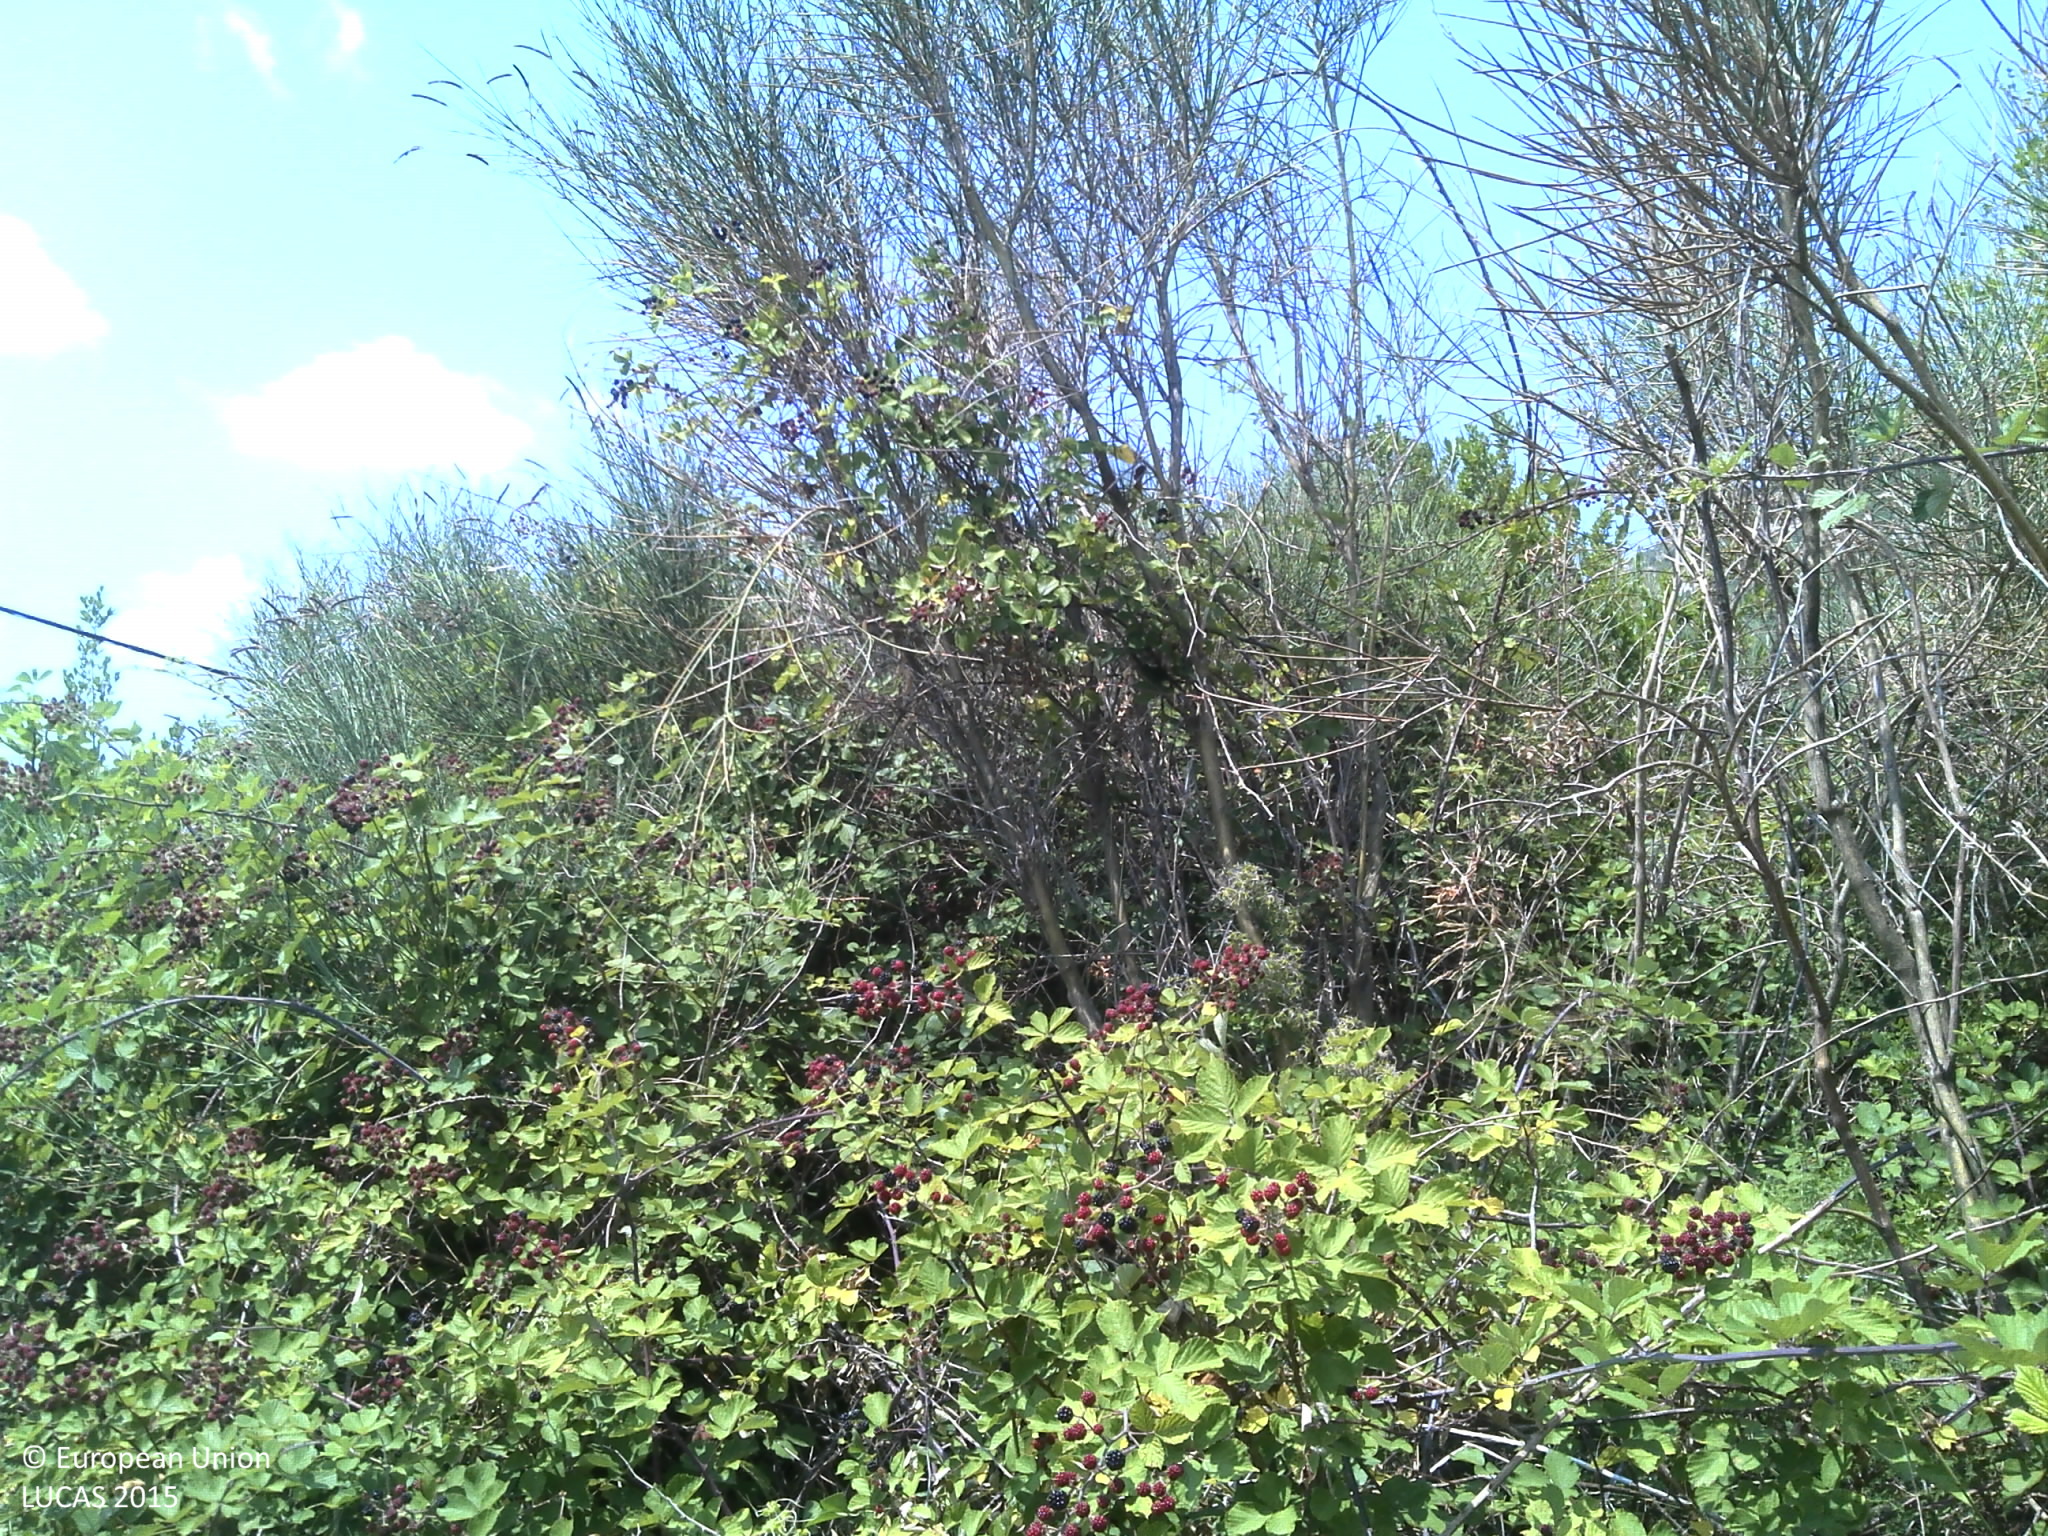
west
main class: Shrubland
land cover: Shrubland with sparse tree cover
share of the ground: > 75 %
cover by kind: shrubs 95 %, broadleaved forest trees 5 %
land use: Semi-natural and natural areas not in use
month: July
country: HR
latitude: 42.9852
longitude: 17.0902
